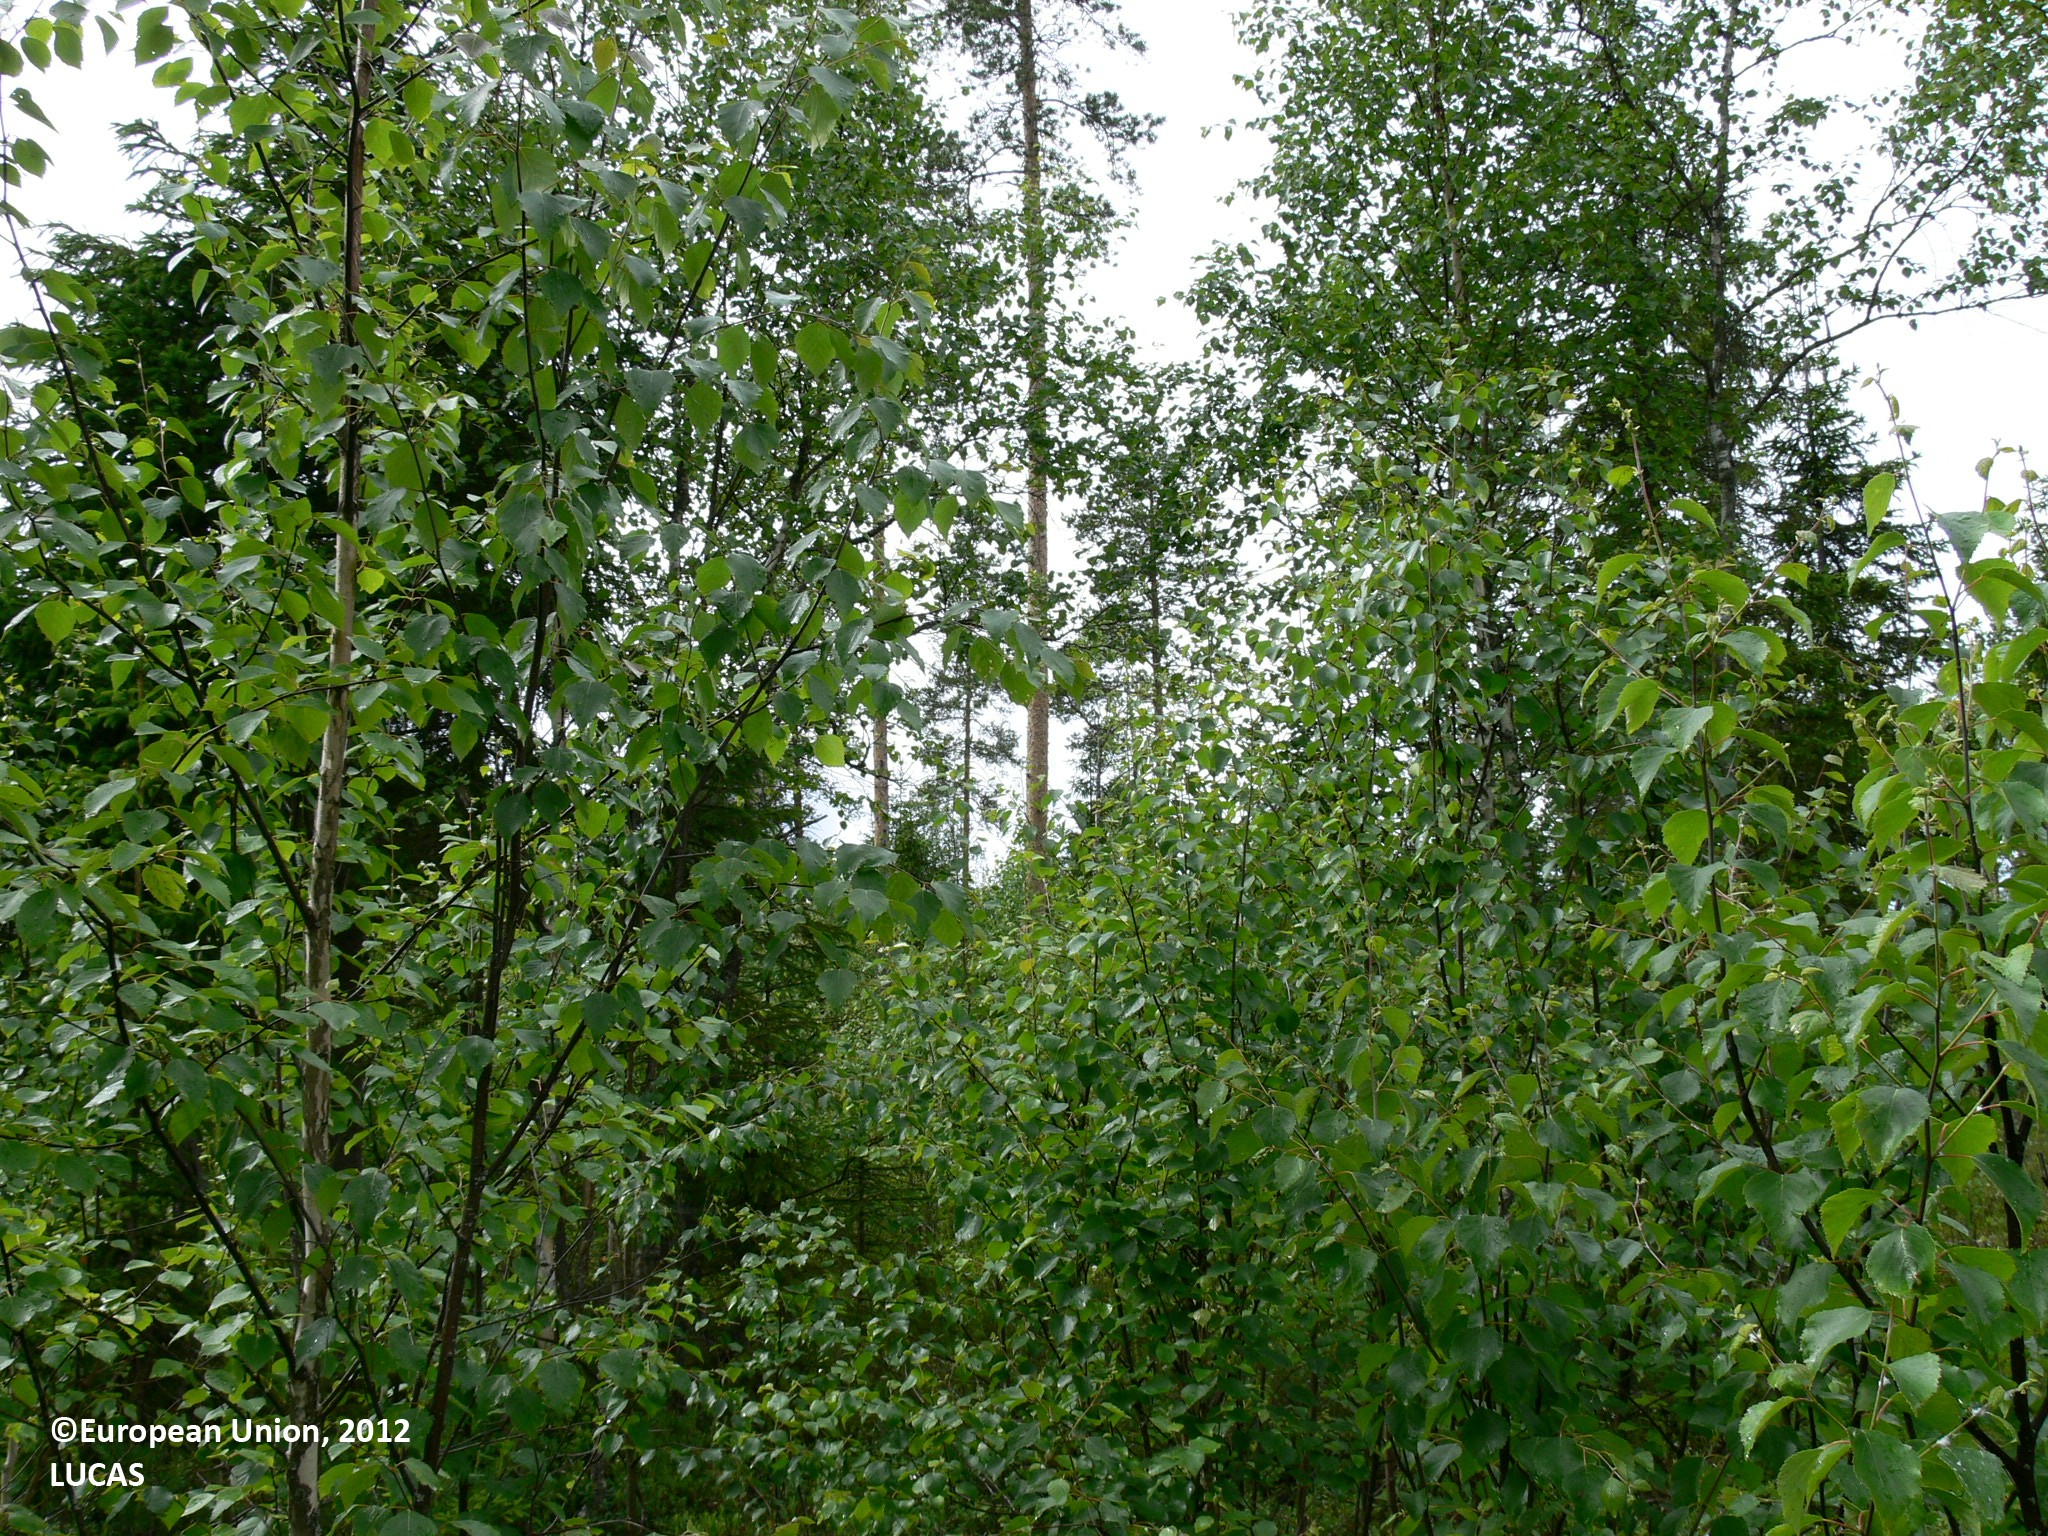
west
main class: Woodland
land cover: Other mixed woodland
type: boreal forest
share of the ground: 50 - 75 %
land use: Forestry
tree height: > 5 m
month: June
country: FI
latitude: 62.9126
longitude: 29.3013
